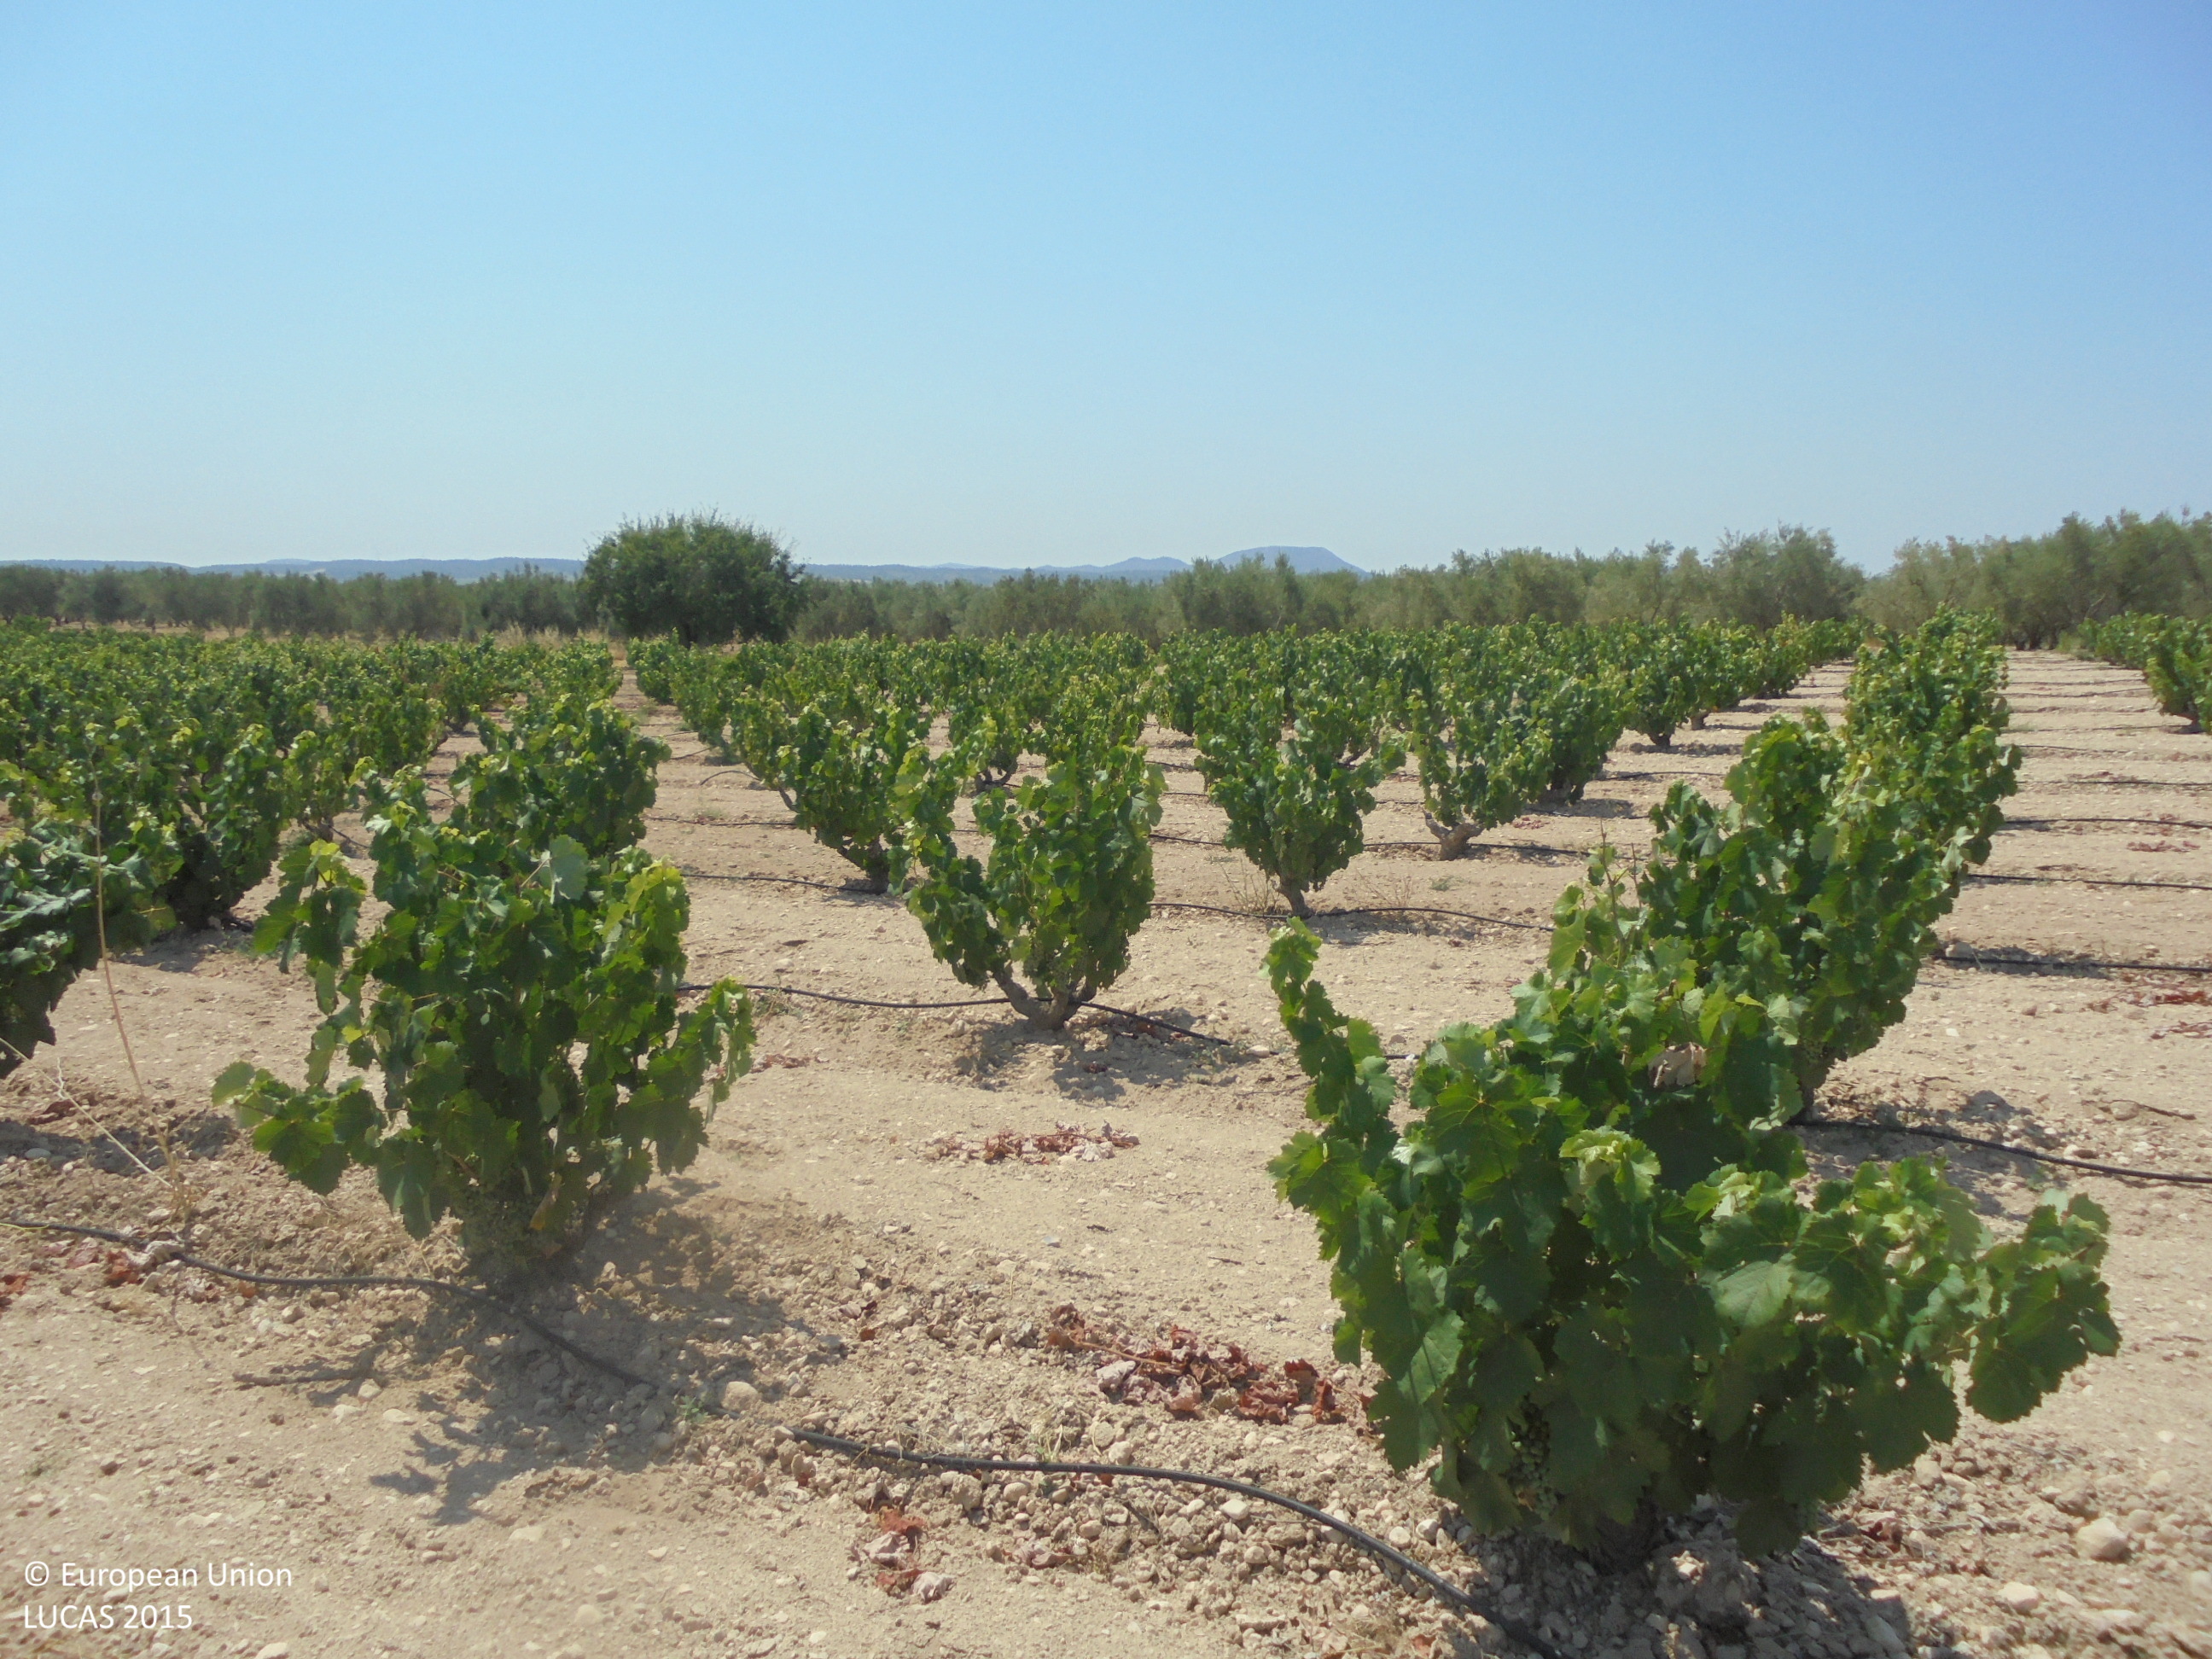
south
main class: Cropland
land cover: Vineyards
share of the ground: 10 - 25 %
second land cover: Other bare soil
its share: > 75 %
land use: Agriculture (excluding fallow land and kitchen gardens)
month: July
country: ES
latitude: 38.5858
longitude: -1.4845
